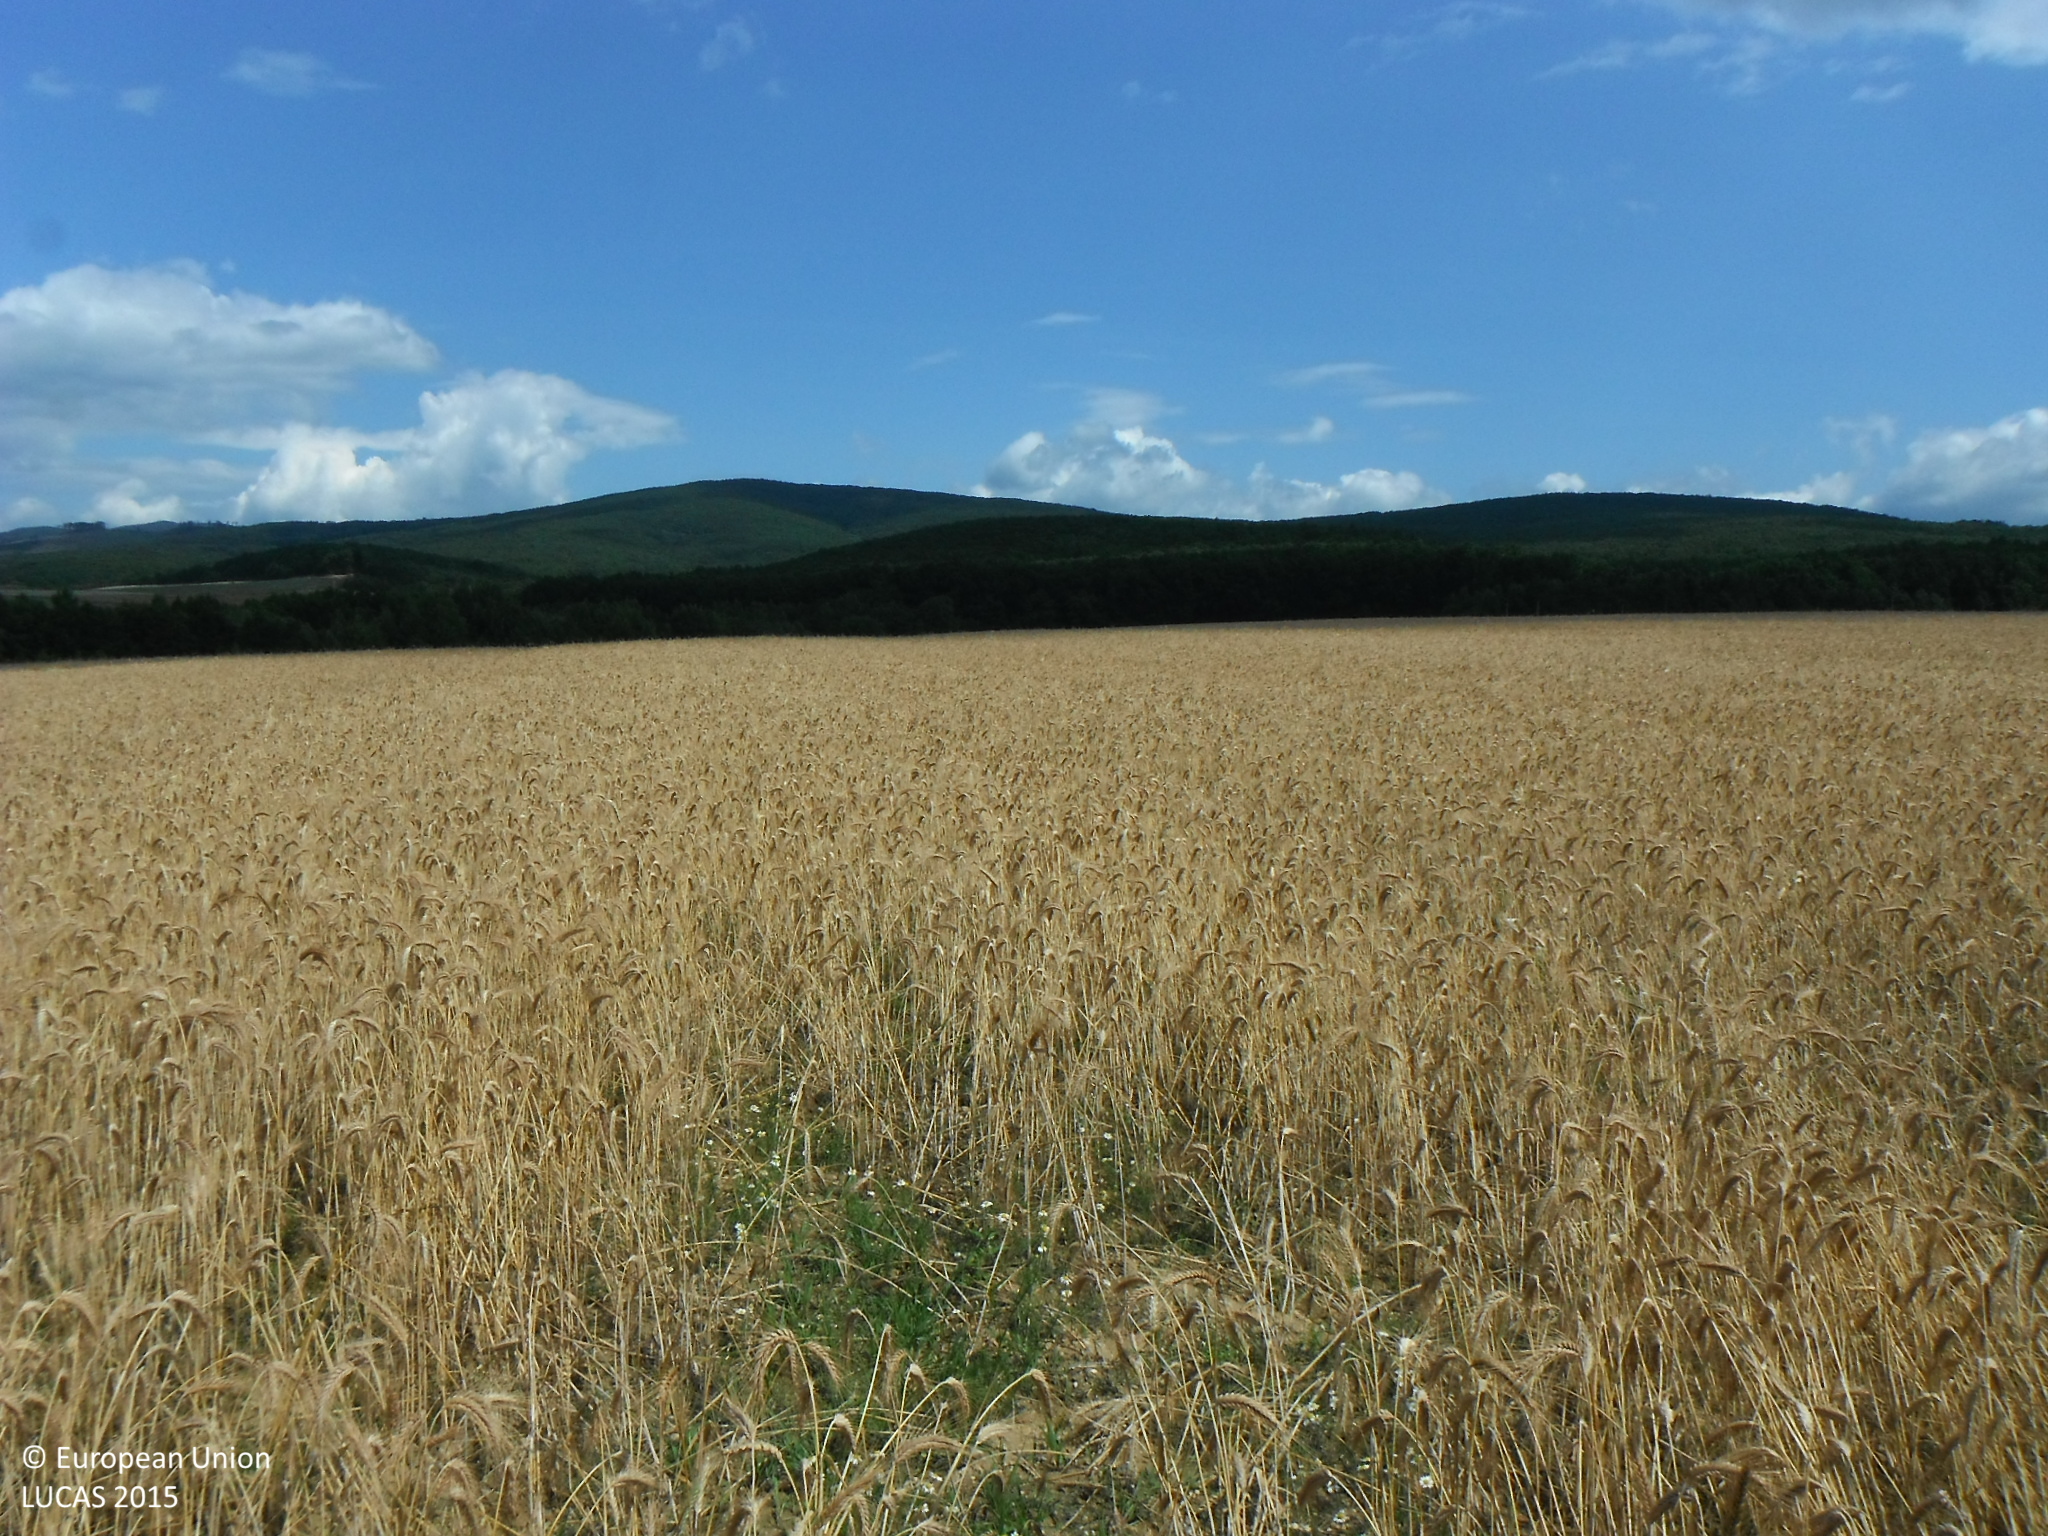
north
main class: Cropland
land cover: Triticale
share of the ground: > 75 %
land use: Agriculture (excluding fallow land and kitchen gardens)
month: July
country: SK
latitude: 48.6797
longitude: 21.0842
